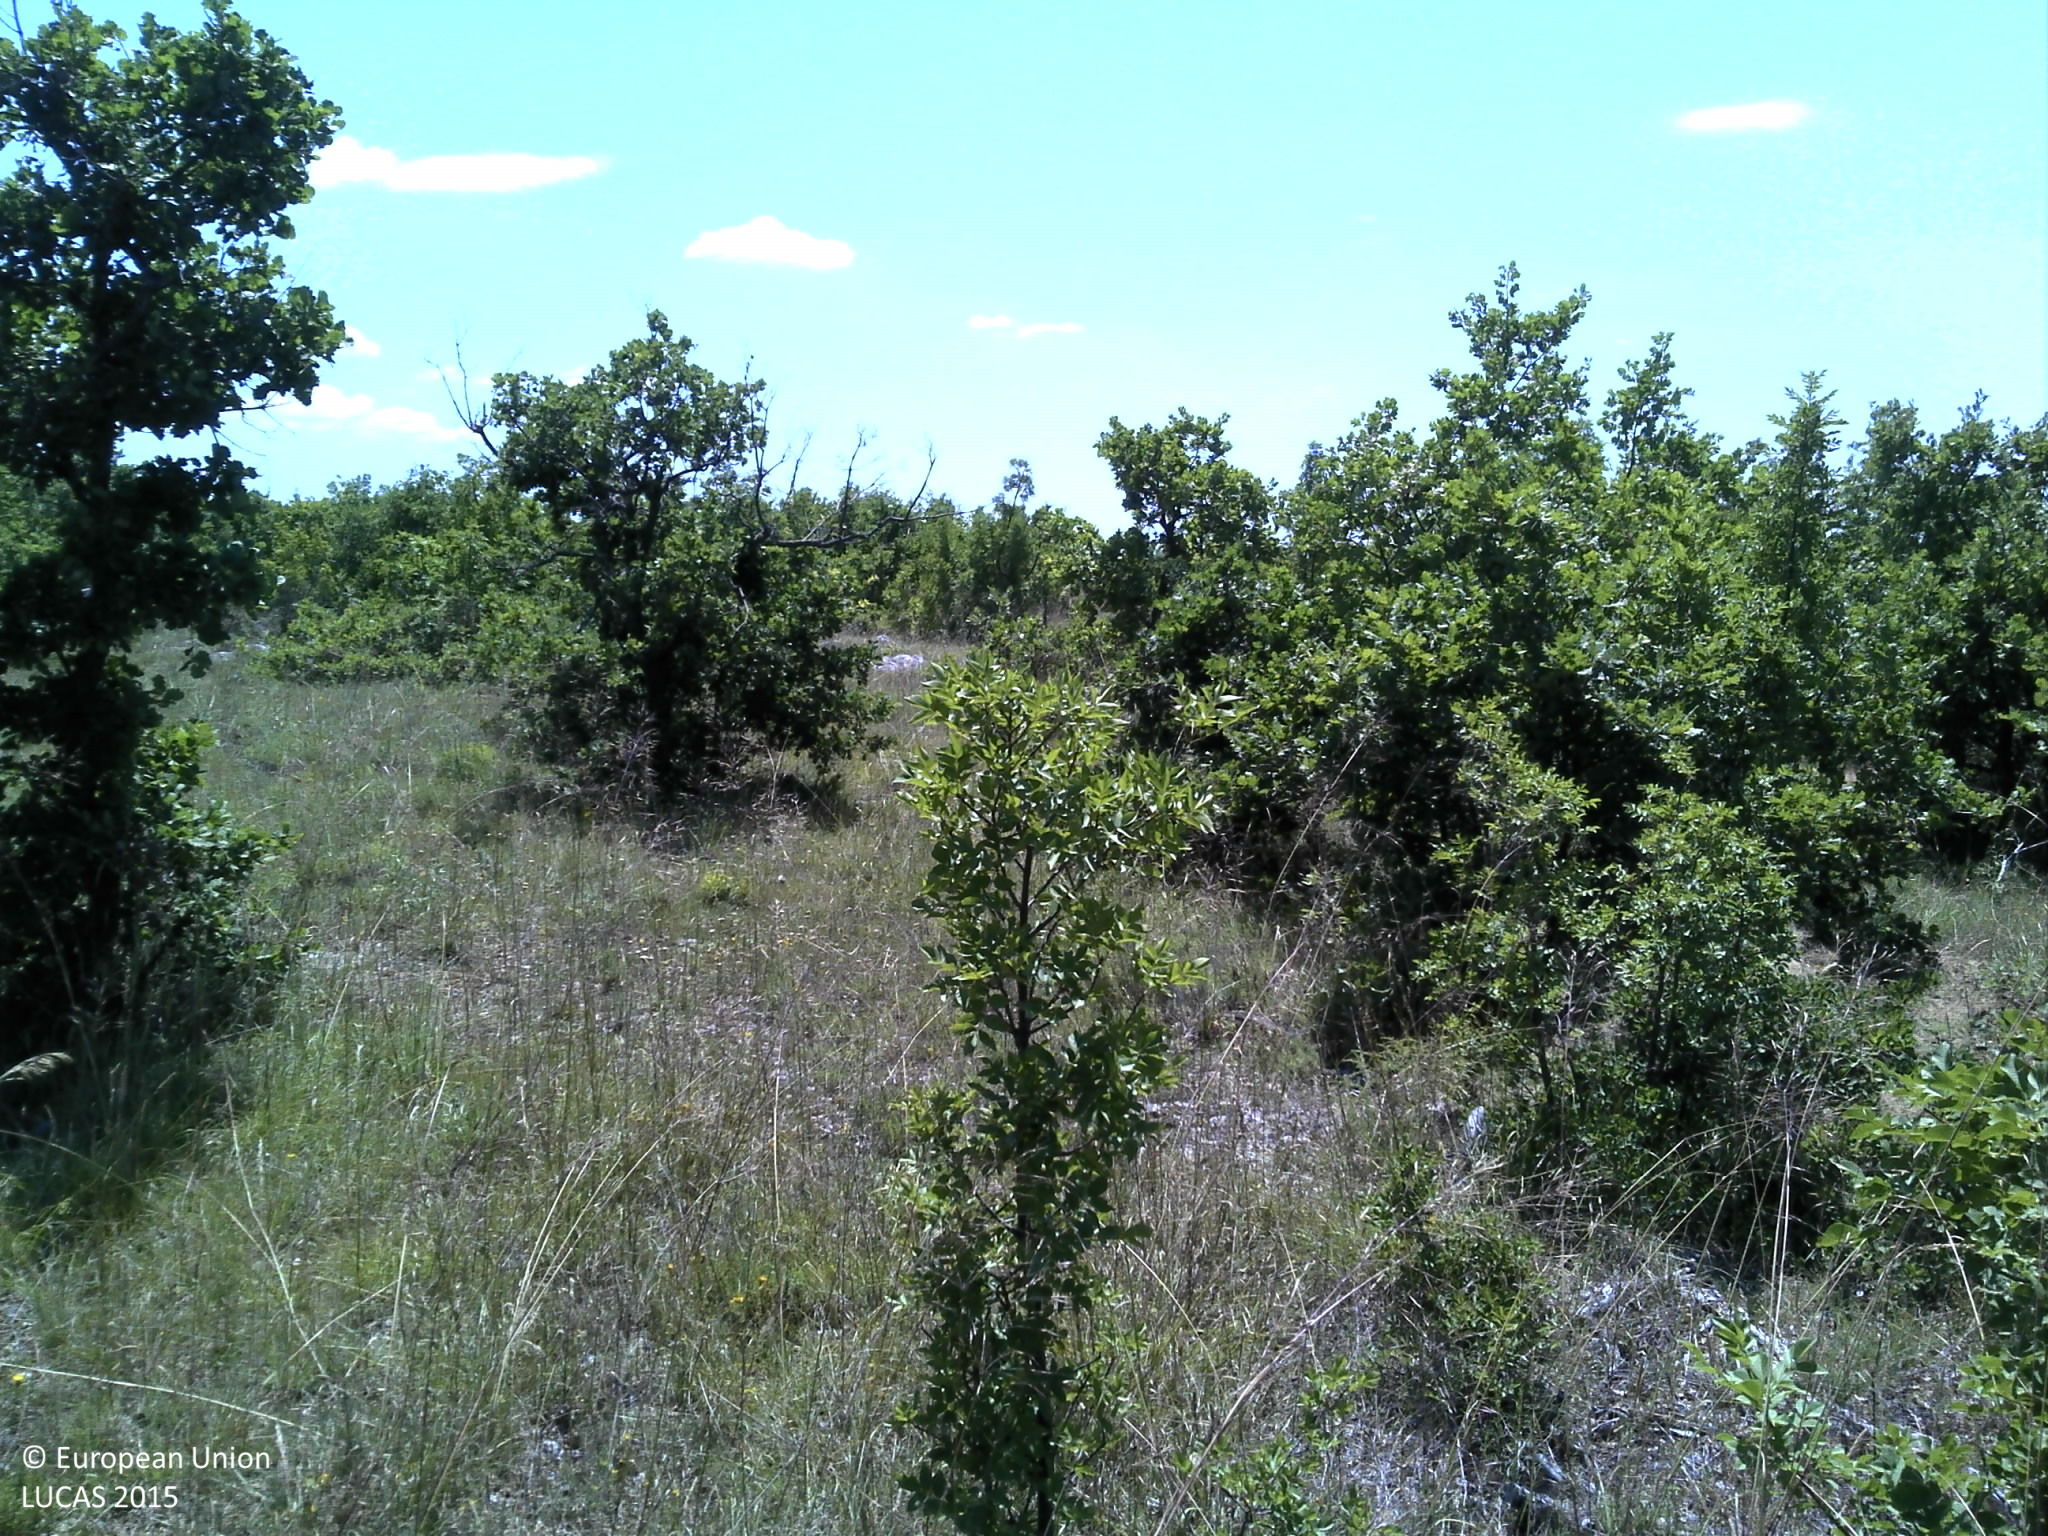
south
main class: Shrubland
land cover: Shrubland with sparse tree cover
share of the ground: 25 - 50 %
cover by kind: shrubs 45 %, herbaceous plants 40 %, broadleaved forest trees 5 %, consolidated bare surface 5 %, unconsolidated bare surface 5 %
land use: Semi-natural and natural areas not in use
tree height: < 5 m
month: July
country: HR
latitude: 43.9053
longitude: 16.0057
